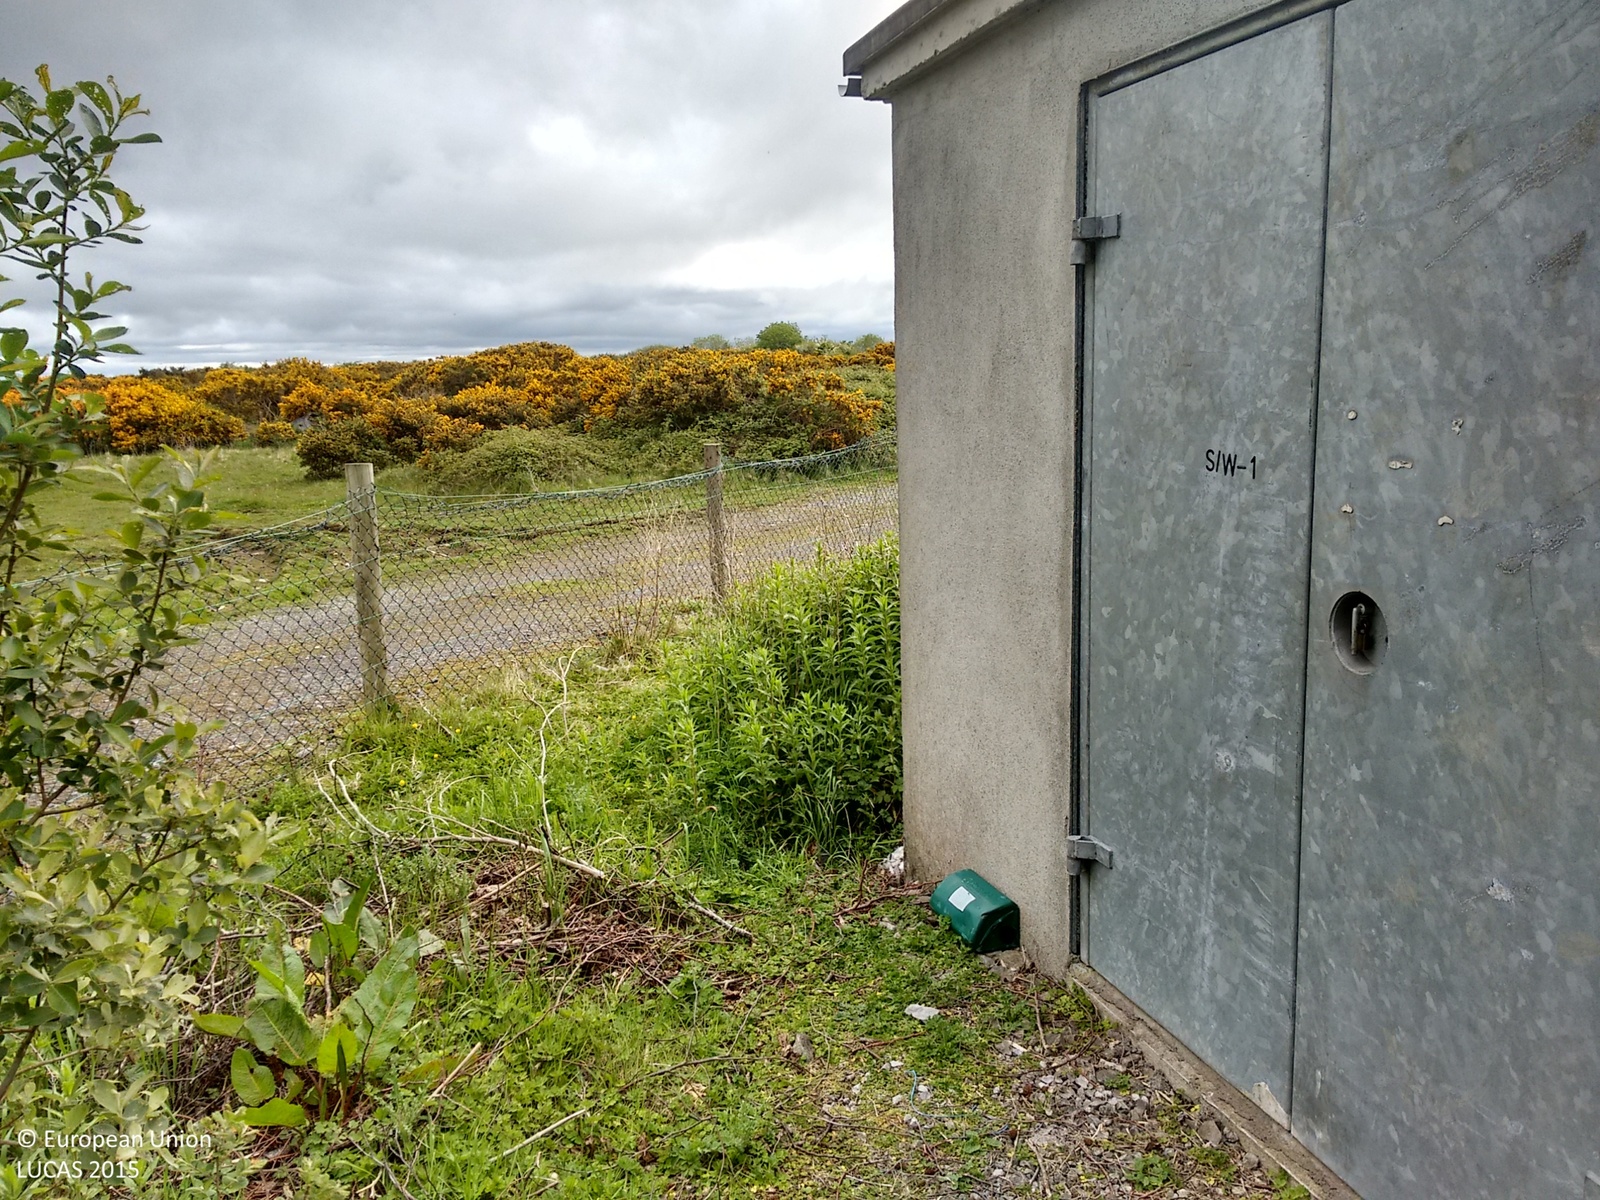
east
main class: Shrubland
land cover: Shrubland without tree cover
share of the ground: > 75 %
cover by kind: herbaceous plants 70 %, shrubs 30 %
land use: Semi-natural and natural areas not in use
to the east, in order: Shrubland without tree cover; Broadleaved woodland; Tracks; Shrubland without tree cover; Lines of trees; Shrubland without tree cover; Broadleaved woodland; Shrubland without tree cover
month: May
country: IE
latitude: 53.3041
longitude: -8.9849
